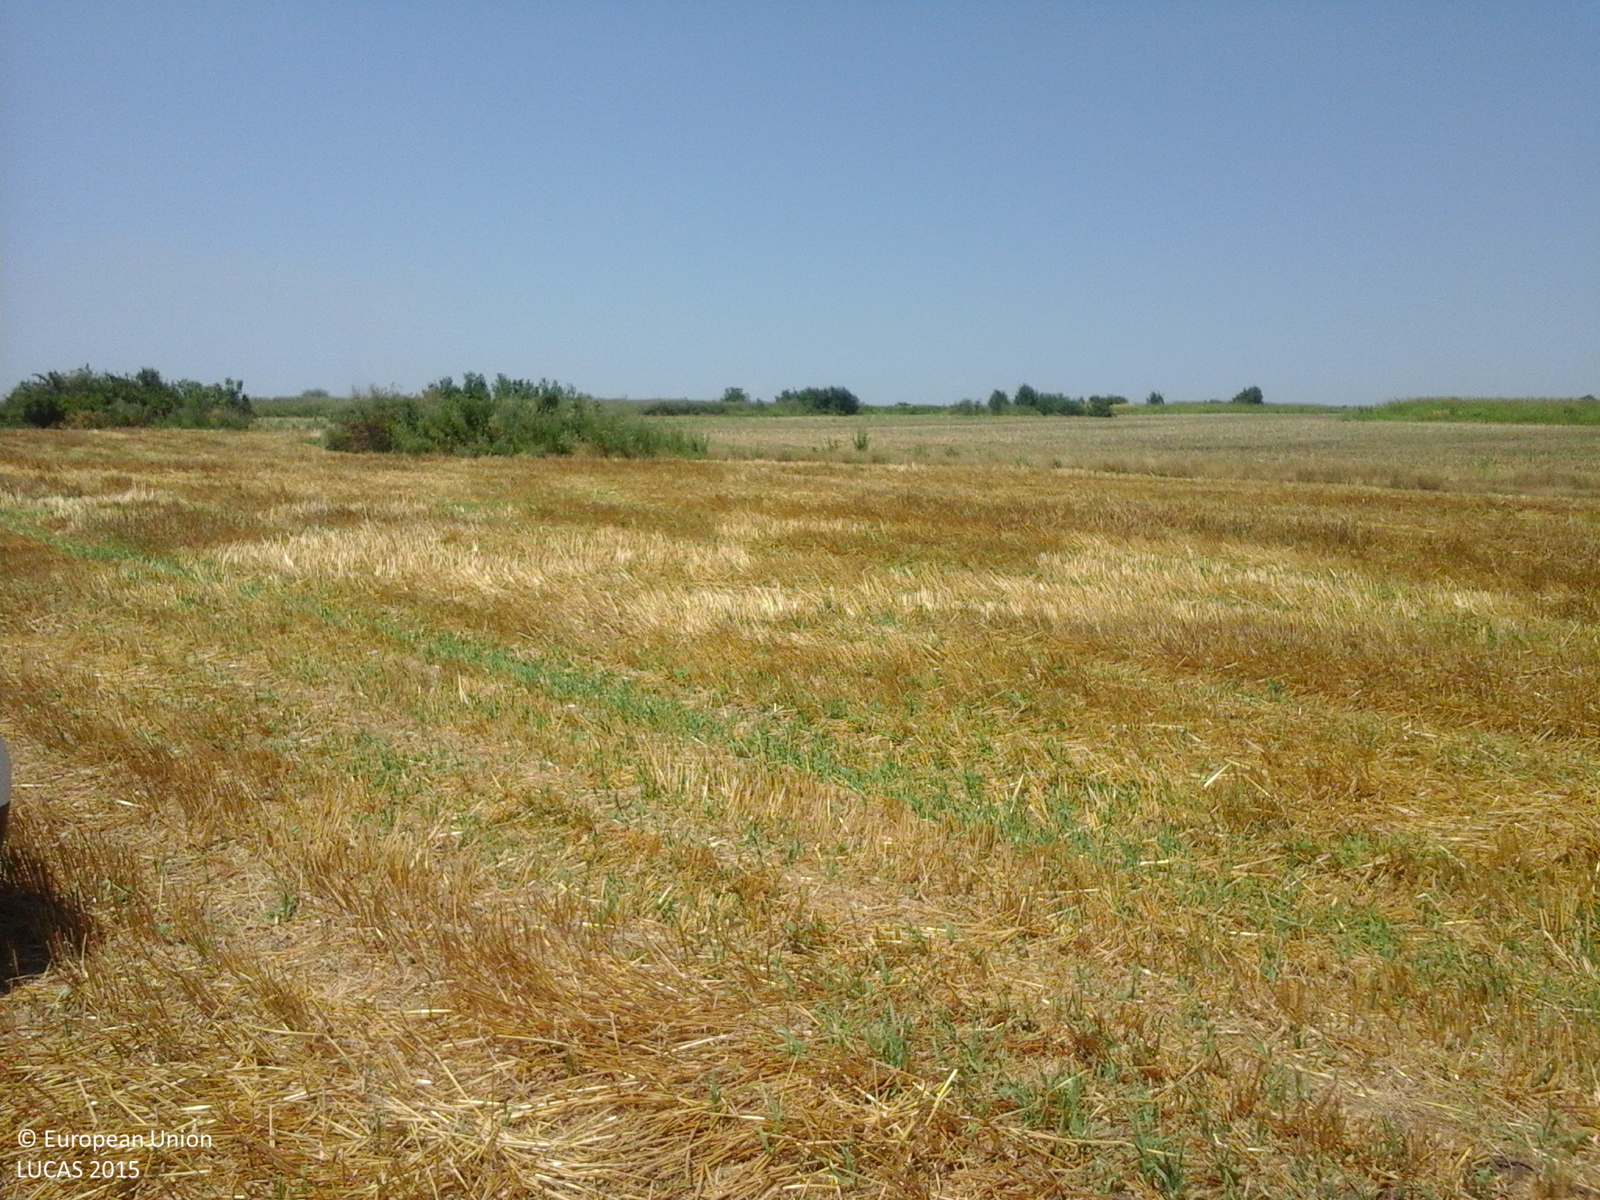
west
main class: Cropland
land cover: Durum wheat
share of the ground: 50 - 75 %
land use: Agriculture (excluding fallow land and kitchen gardens)
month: July
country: RO
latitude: 44.2810
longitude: 27.3140
